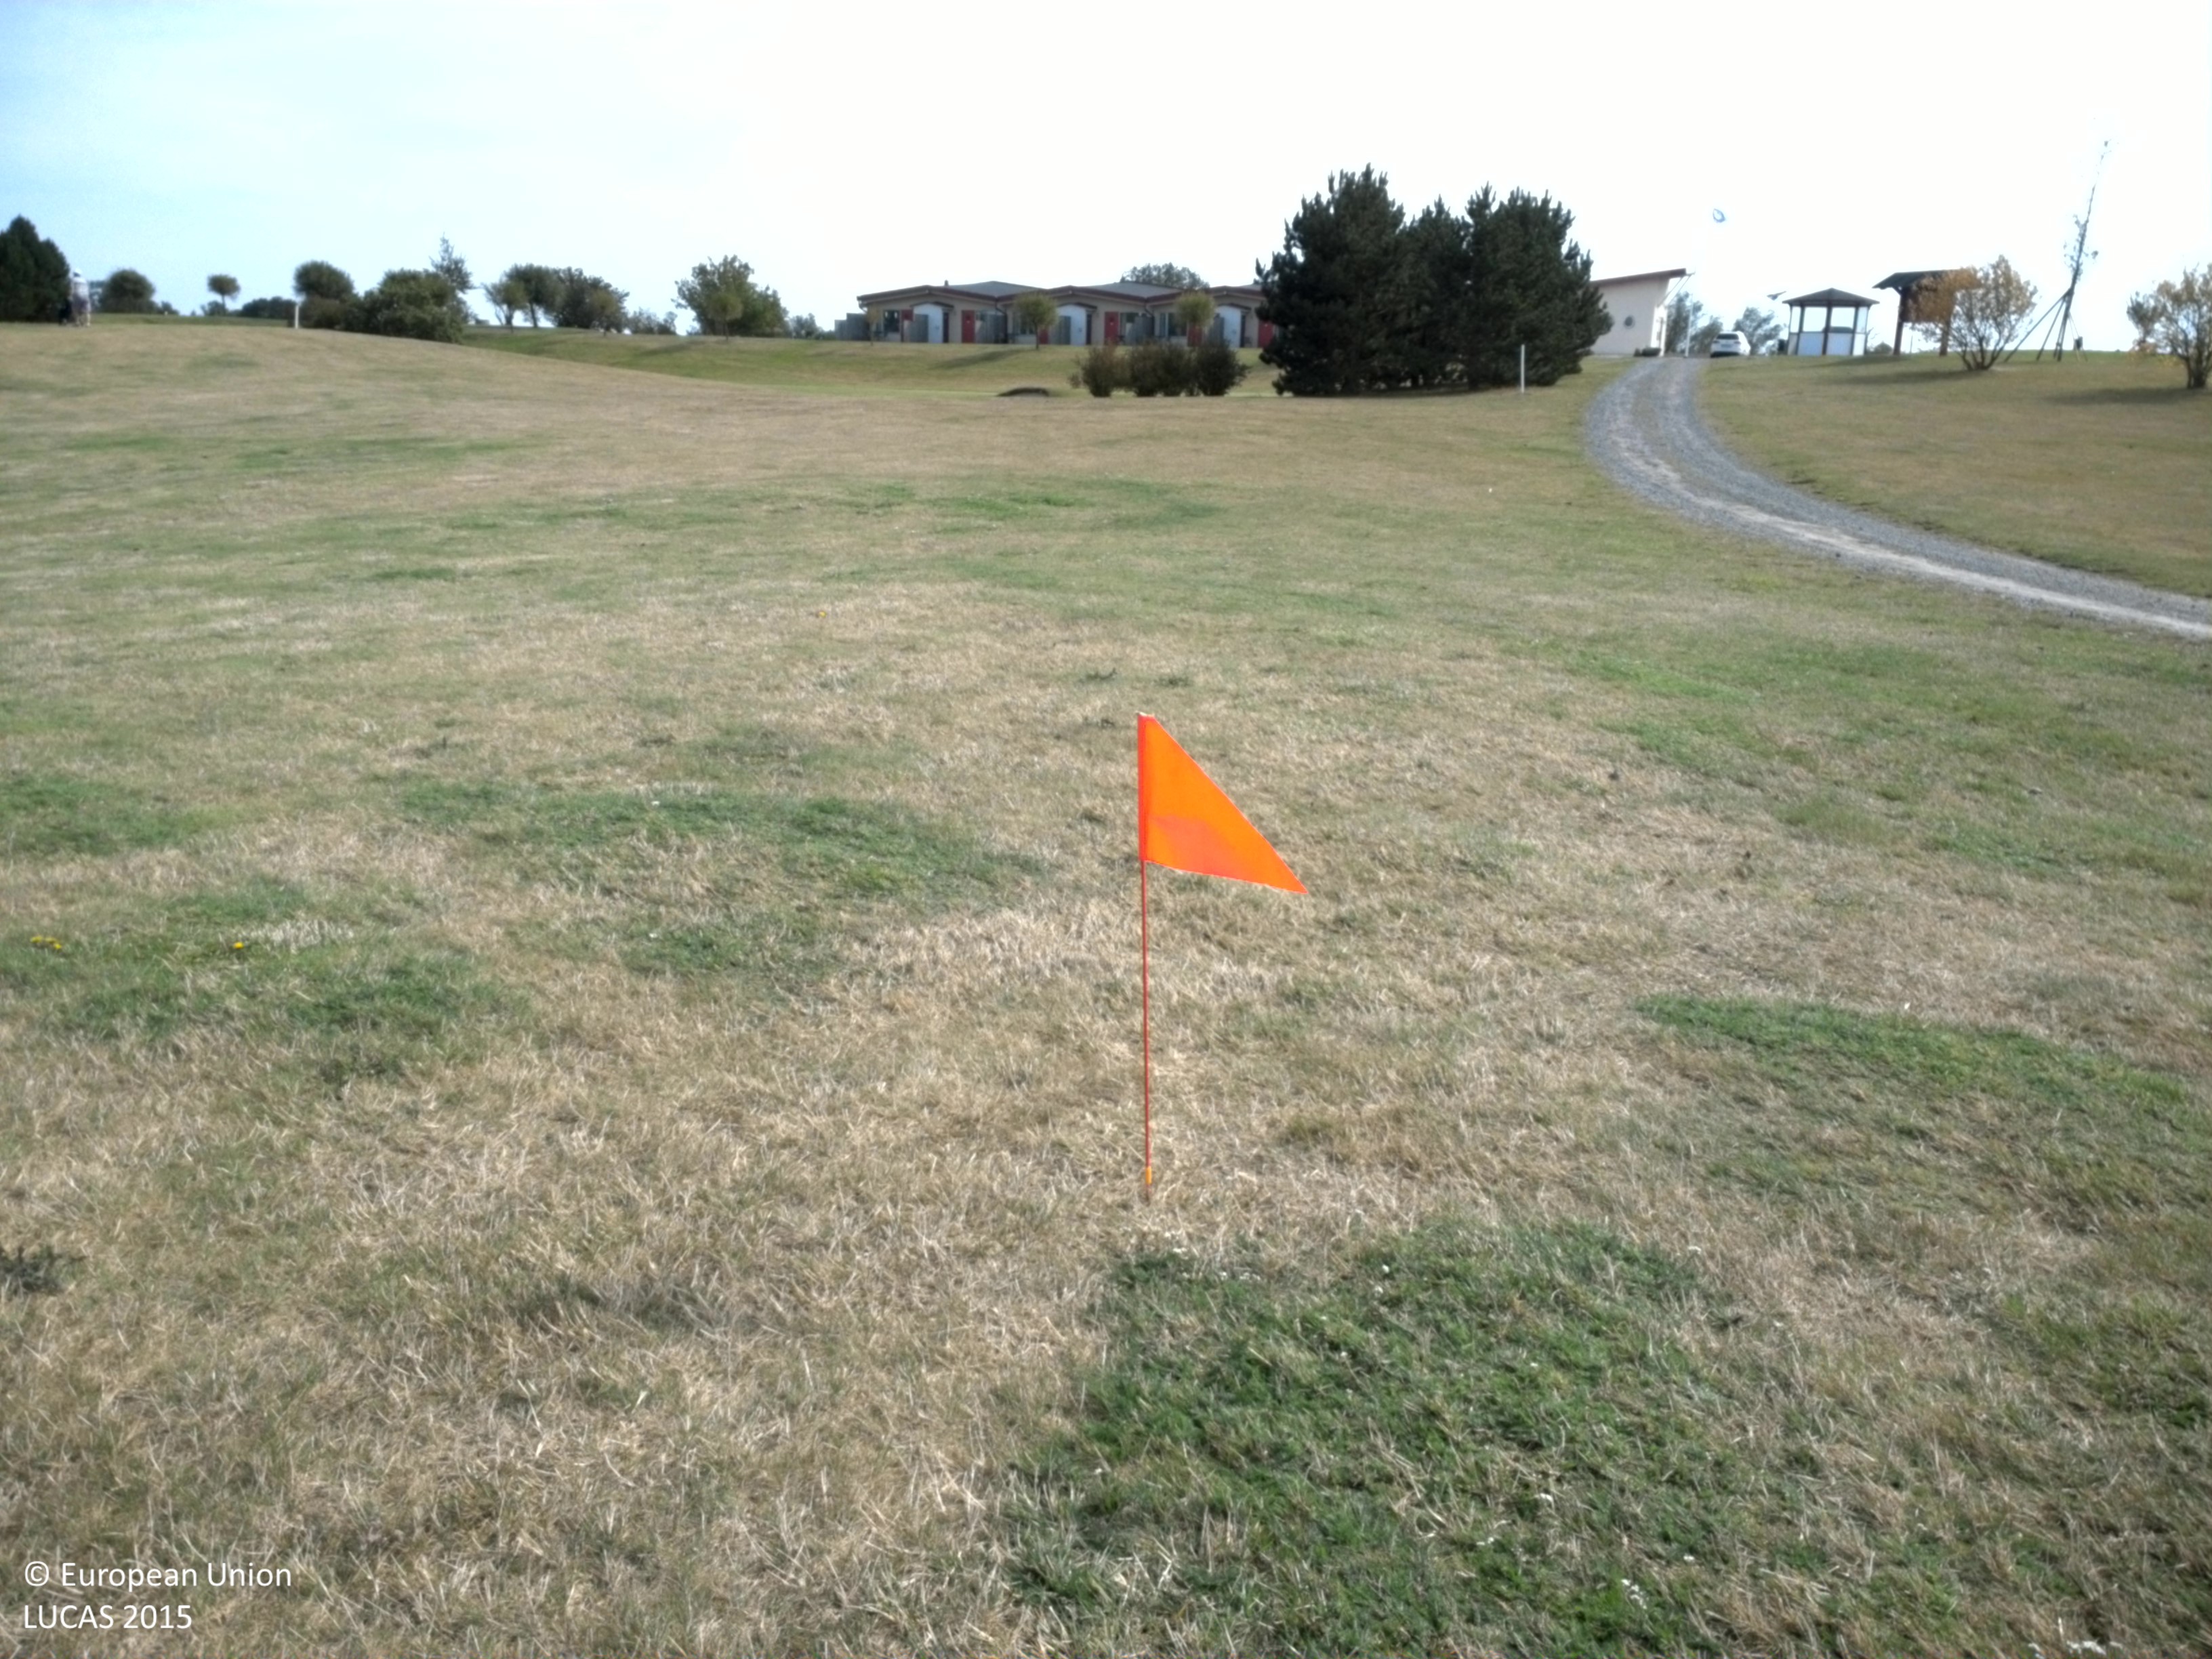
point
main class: Grassland
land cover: Grassland without tree/shrub cover
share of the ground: > 75 %
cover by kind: herbaceous plants 100 %
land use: Sport
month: September
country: SE
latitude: 55.5323
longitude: 13.9752
